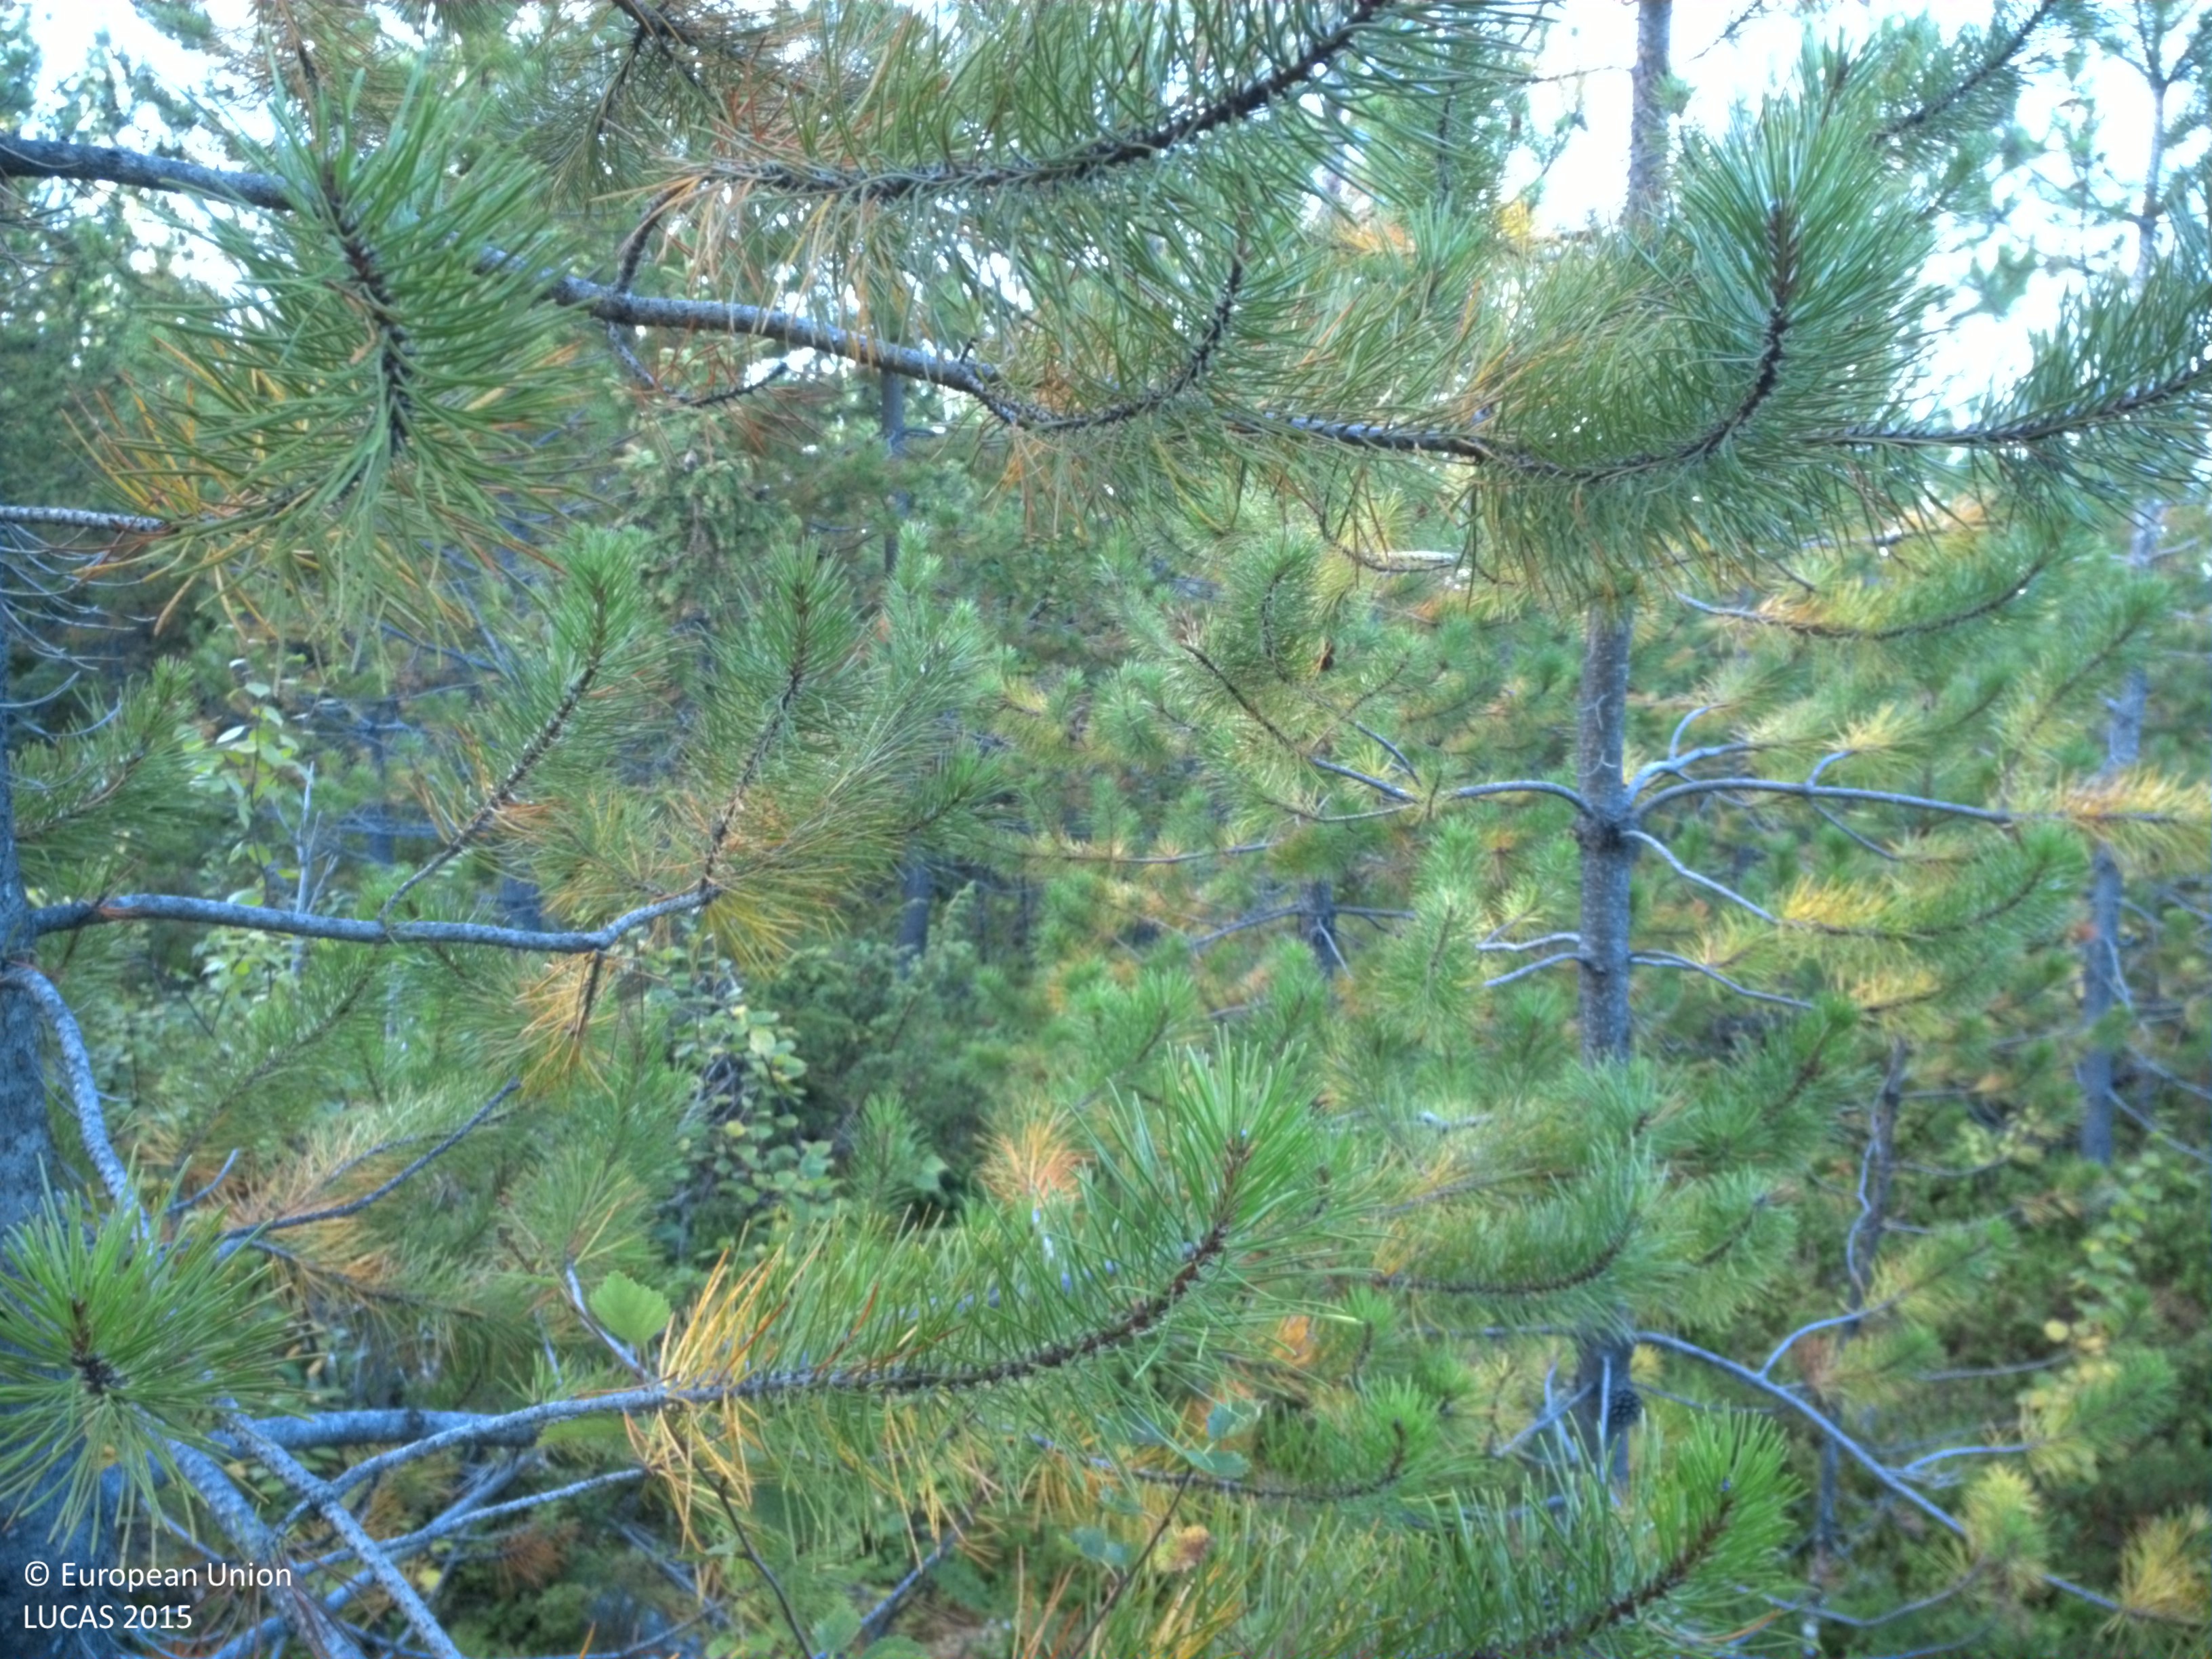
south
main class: Woodland
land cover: Pine dominated coniferous woodland
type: exotic forest
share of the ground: > 75 %
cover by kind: coniferous forest trees 75 %, shrubs 15 %, broadleaved forest trees 5 %, herbaceous plants 5 %
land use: Forestry
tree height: > 5 m
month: September
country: SE
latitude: 65.1773
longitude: 17.6262
